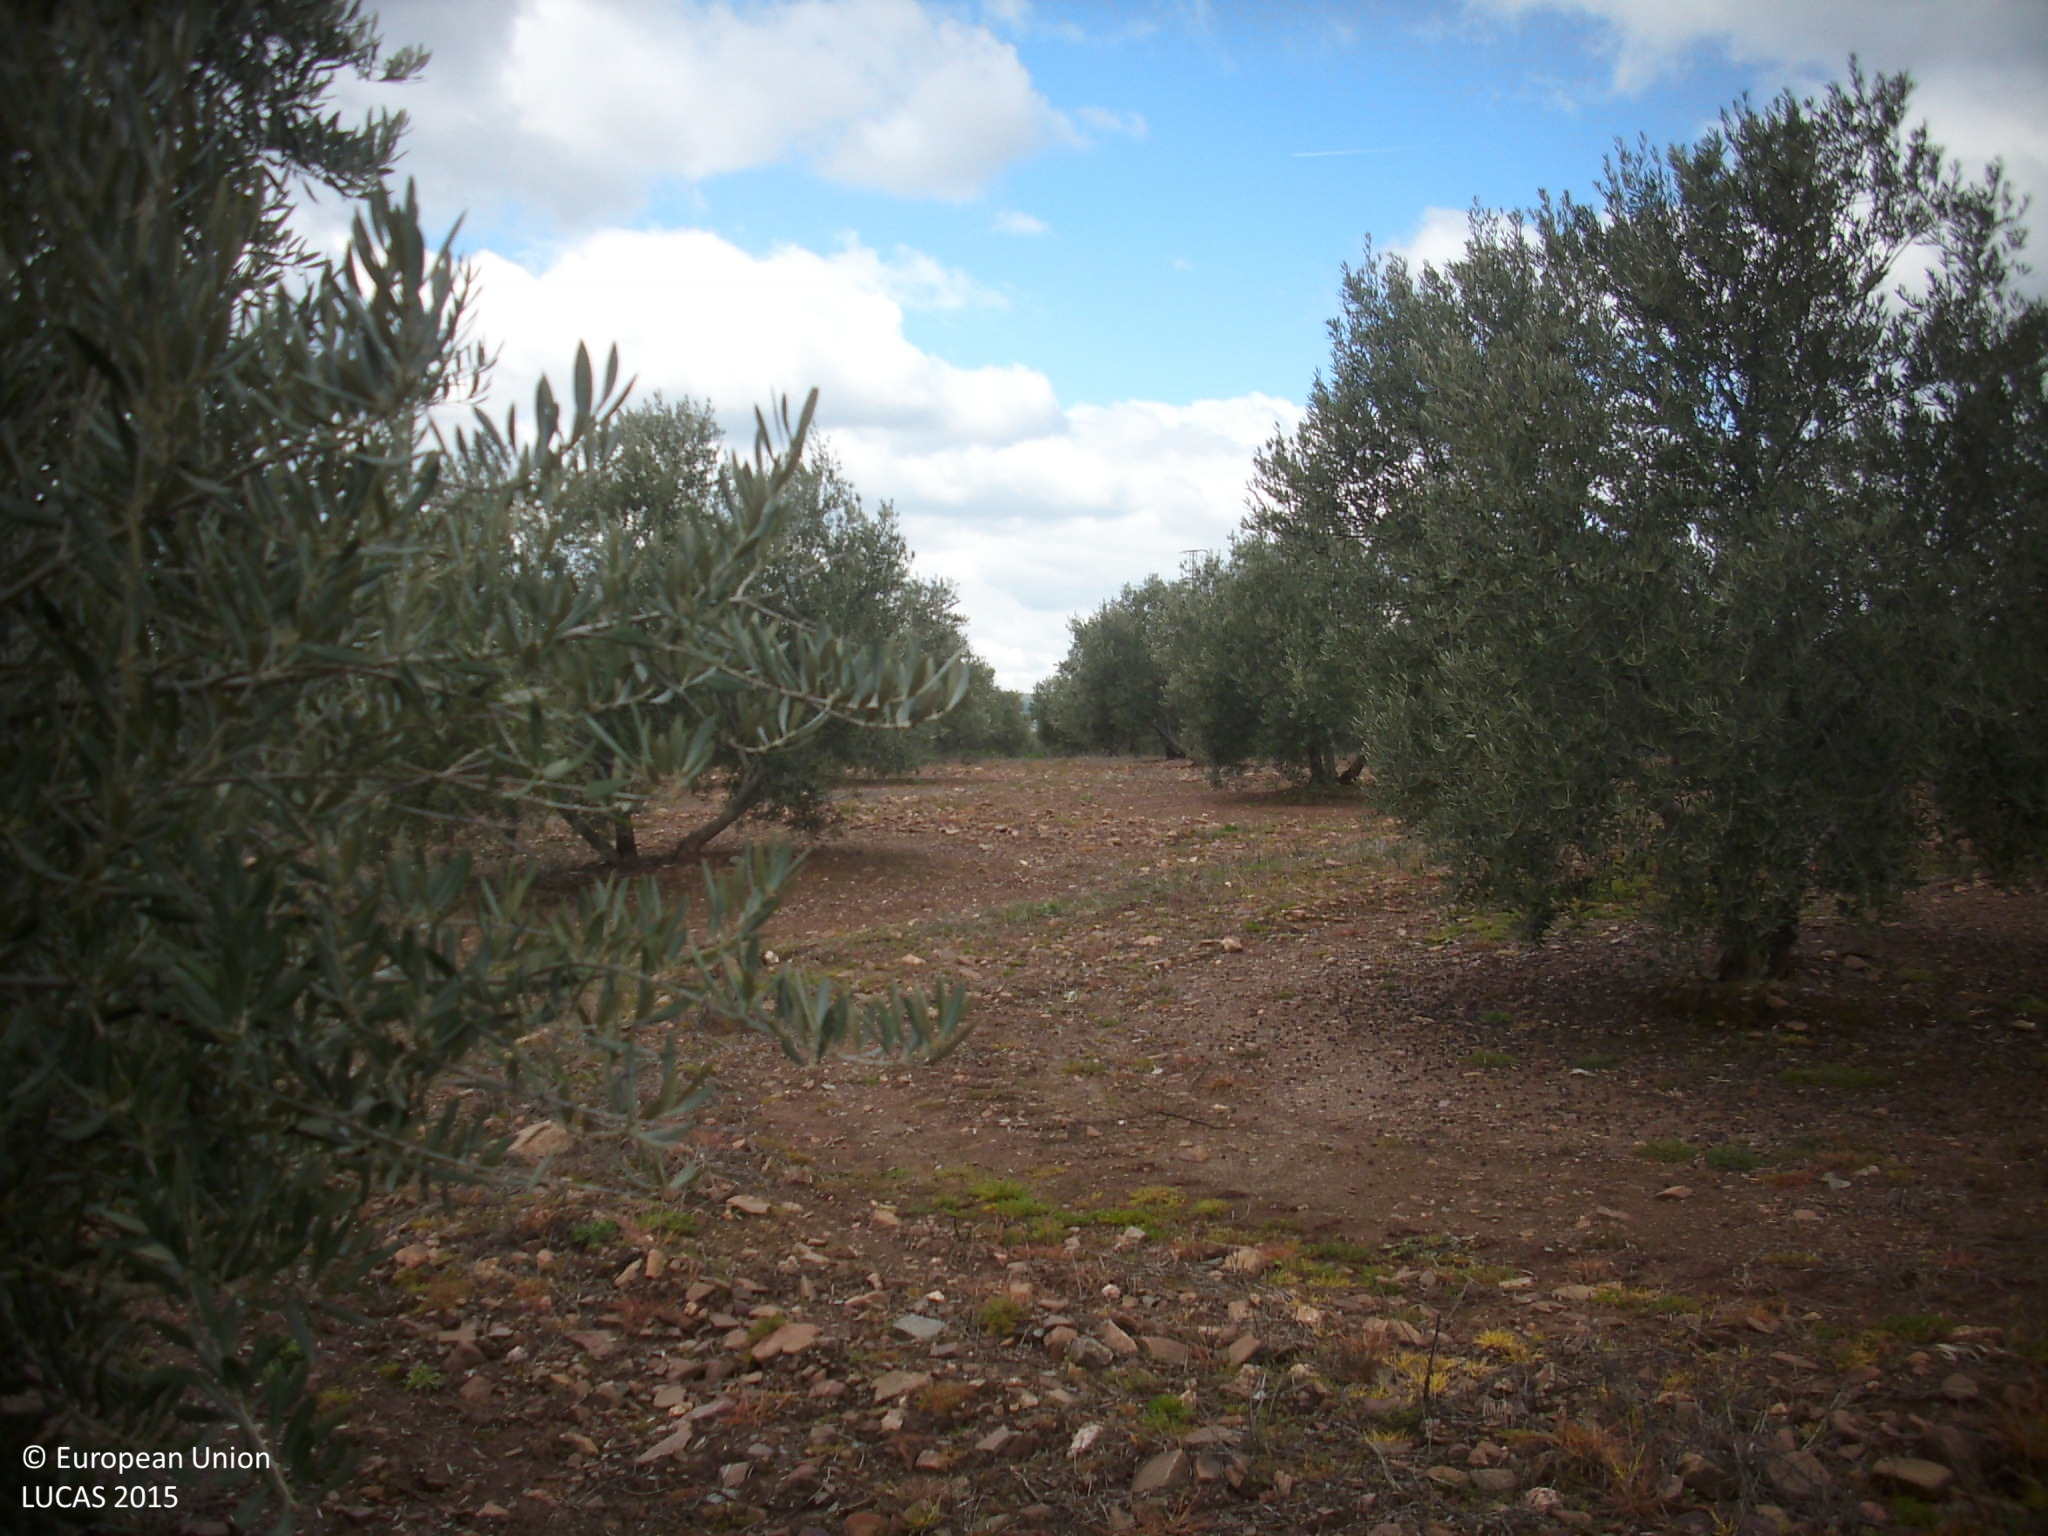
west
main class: Cropland
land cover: Olive groves
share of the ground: 25 - 50 %
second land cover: Spontaneously vegetated surfaces
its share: 10 - 25 %
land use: Agriculture (excluding fallow land and kitchen gardens)
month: March
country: ES
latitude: 38.3405
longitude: -3.1023
